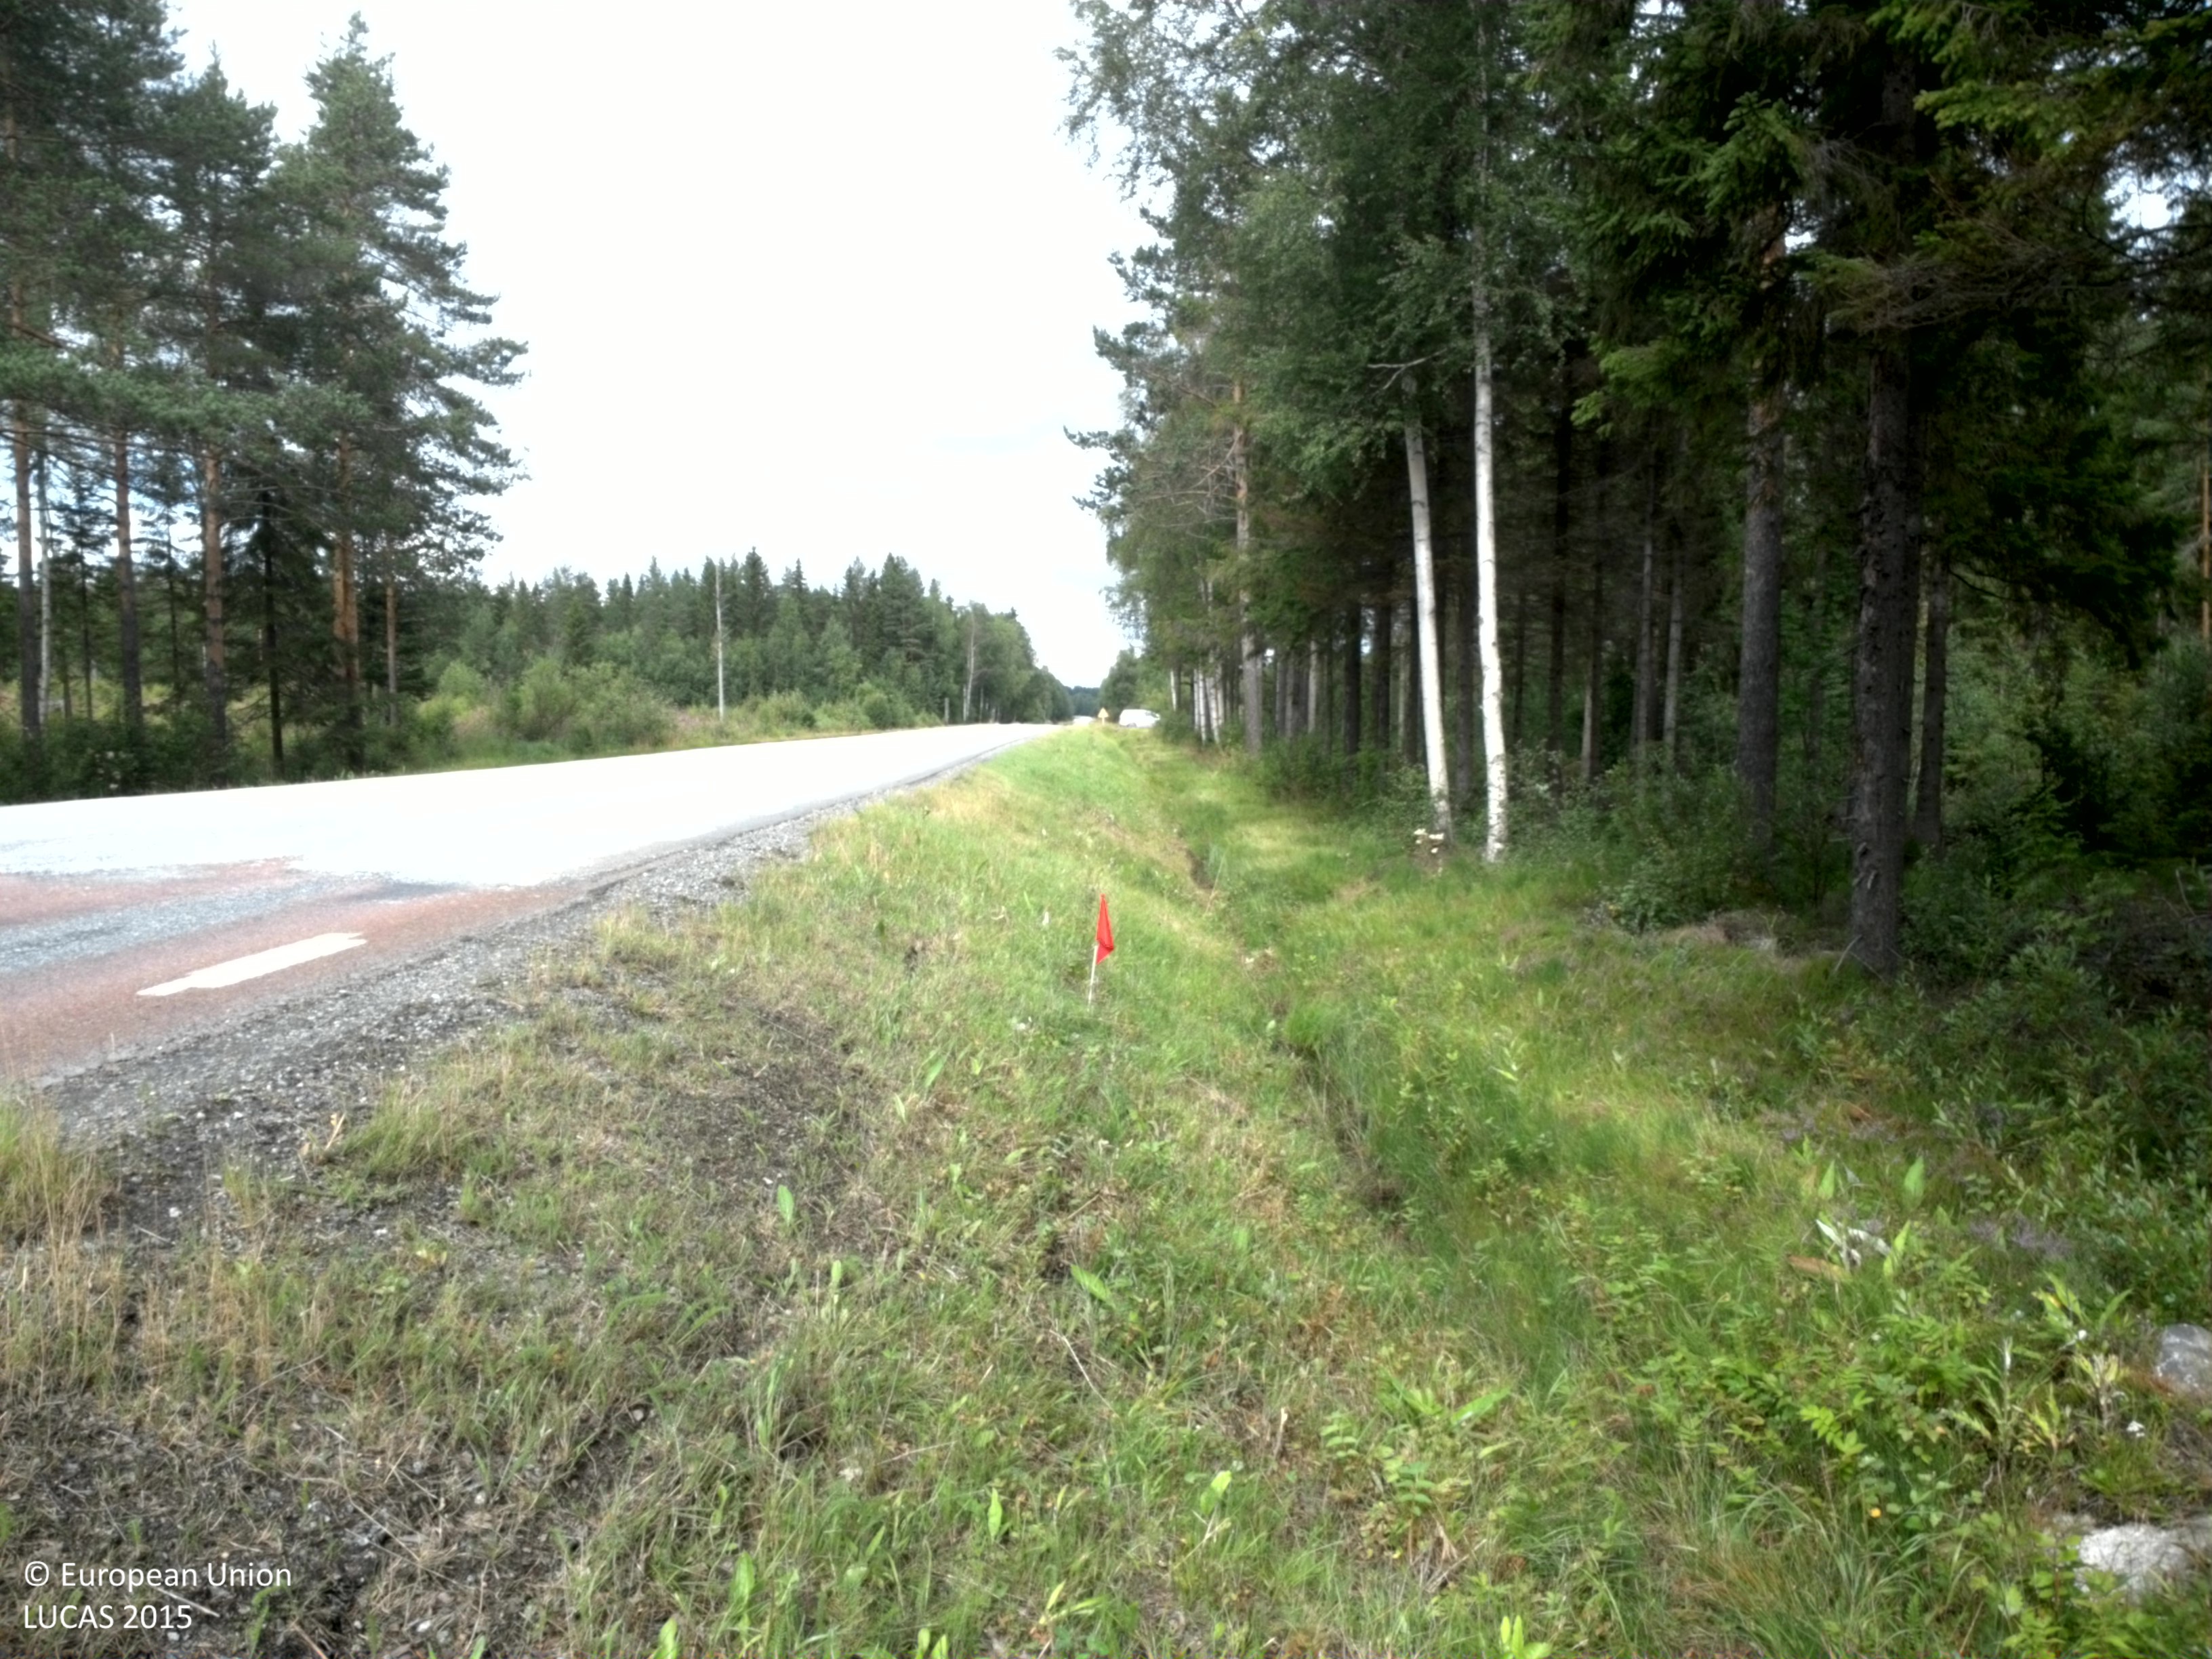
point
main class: Woodland
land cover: Spruce dominated mixed woodland
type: boreal forest
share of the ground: 50 - 75 %
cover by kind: coniferous forest trees 45 %, shrubs 25 %, broadleaved forest trees 15 %, herbaceous plants 10 %, lichens and mosses 5 %
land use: Forestry
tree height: > 5 m
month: August
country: SE
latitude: 64.6207
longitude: 20.9575
